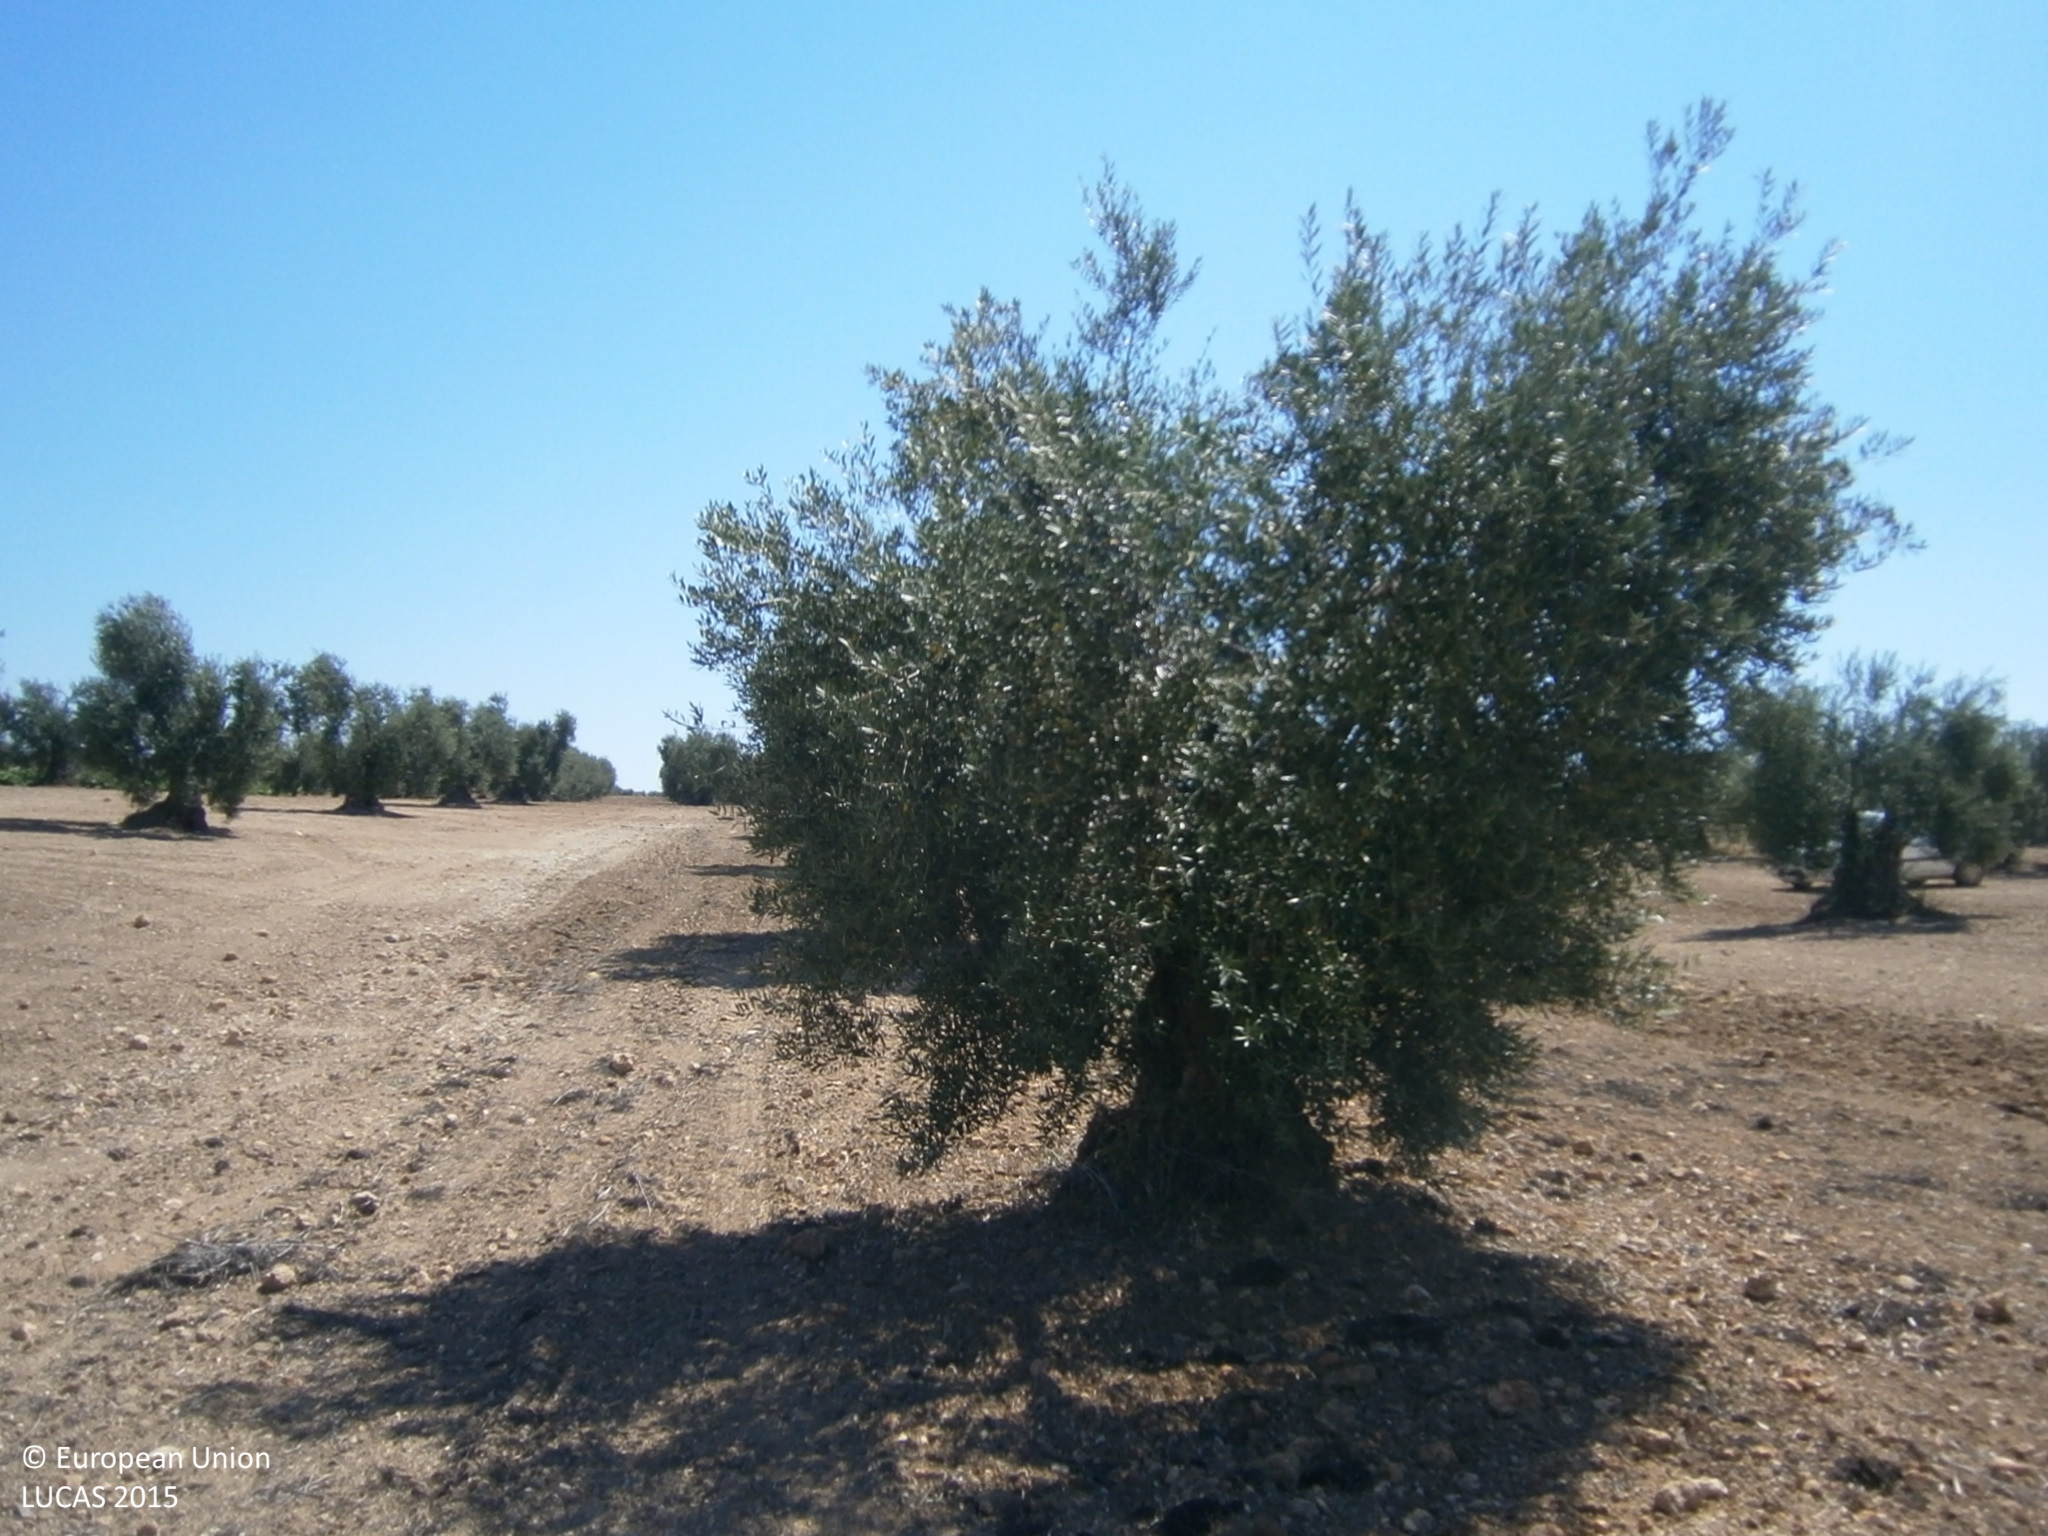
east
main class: Cropland
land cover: Olive groves
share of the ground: 10 - 25 %
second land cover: Other bare soil
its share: > 75 %
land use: Agriculture (excluding fallow land and kitchen gardens)
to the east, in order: Olive groves; Other bare soil; Grass margins; Vineyards; Olive groves
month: June
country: ES
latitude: 38.7430
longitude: -6.6394
